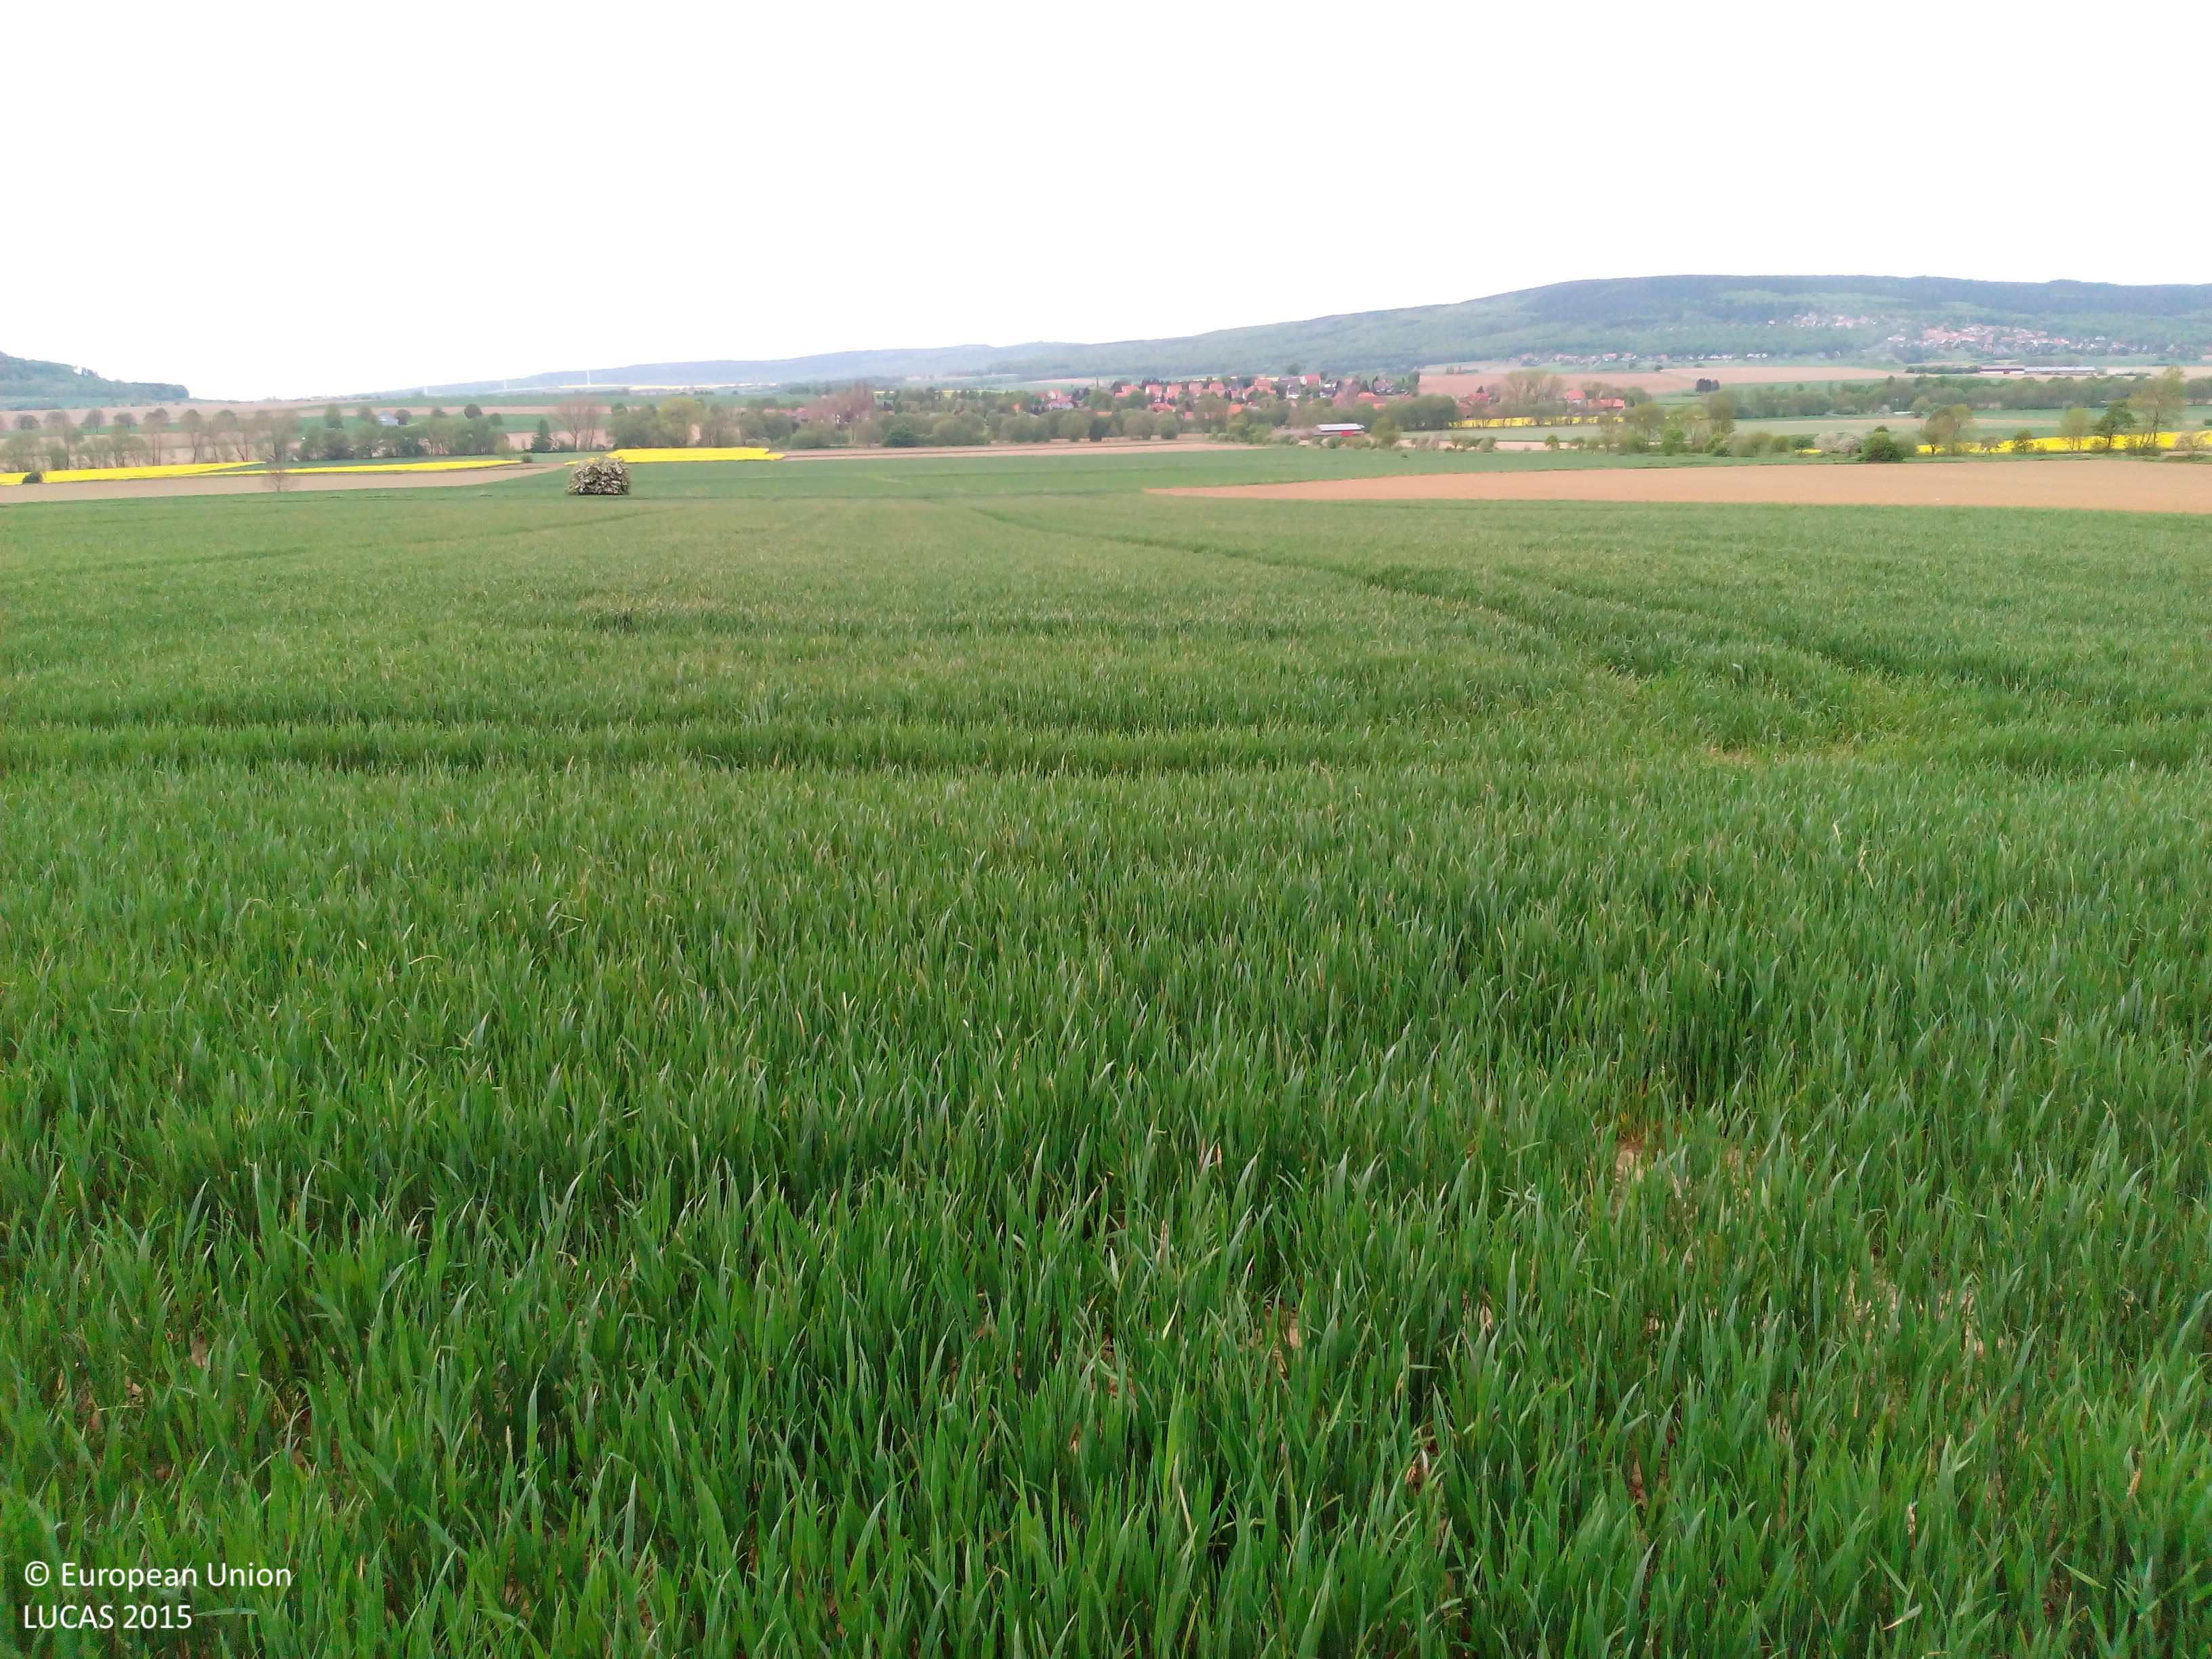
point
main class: Cropland
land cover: Common wheat
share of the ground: > 75 %
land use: Agriculture (excluding fallow land and kitchen gardens)
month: May
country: DE
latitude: 52.0712
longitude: 9.6062
